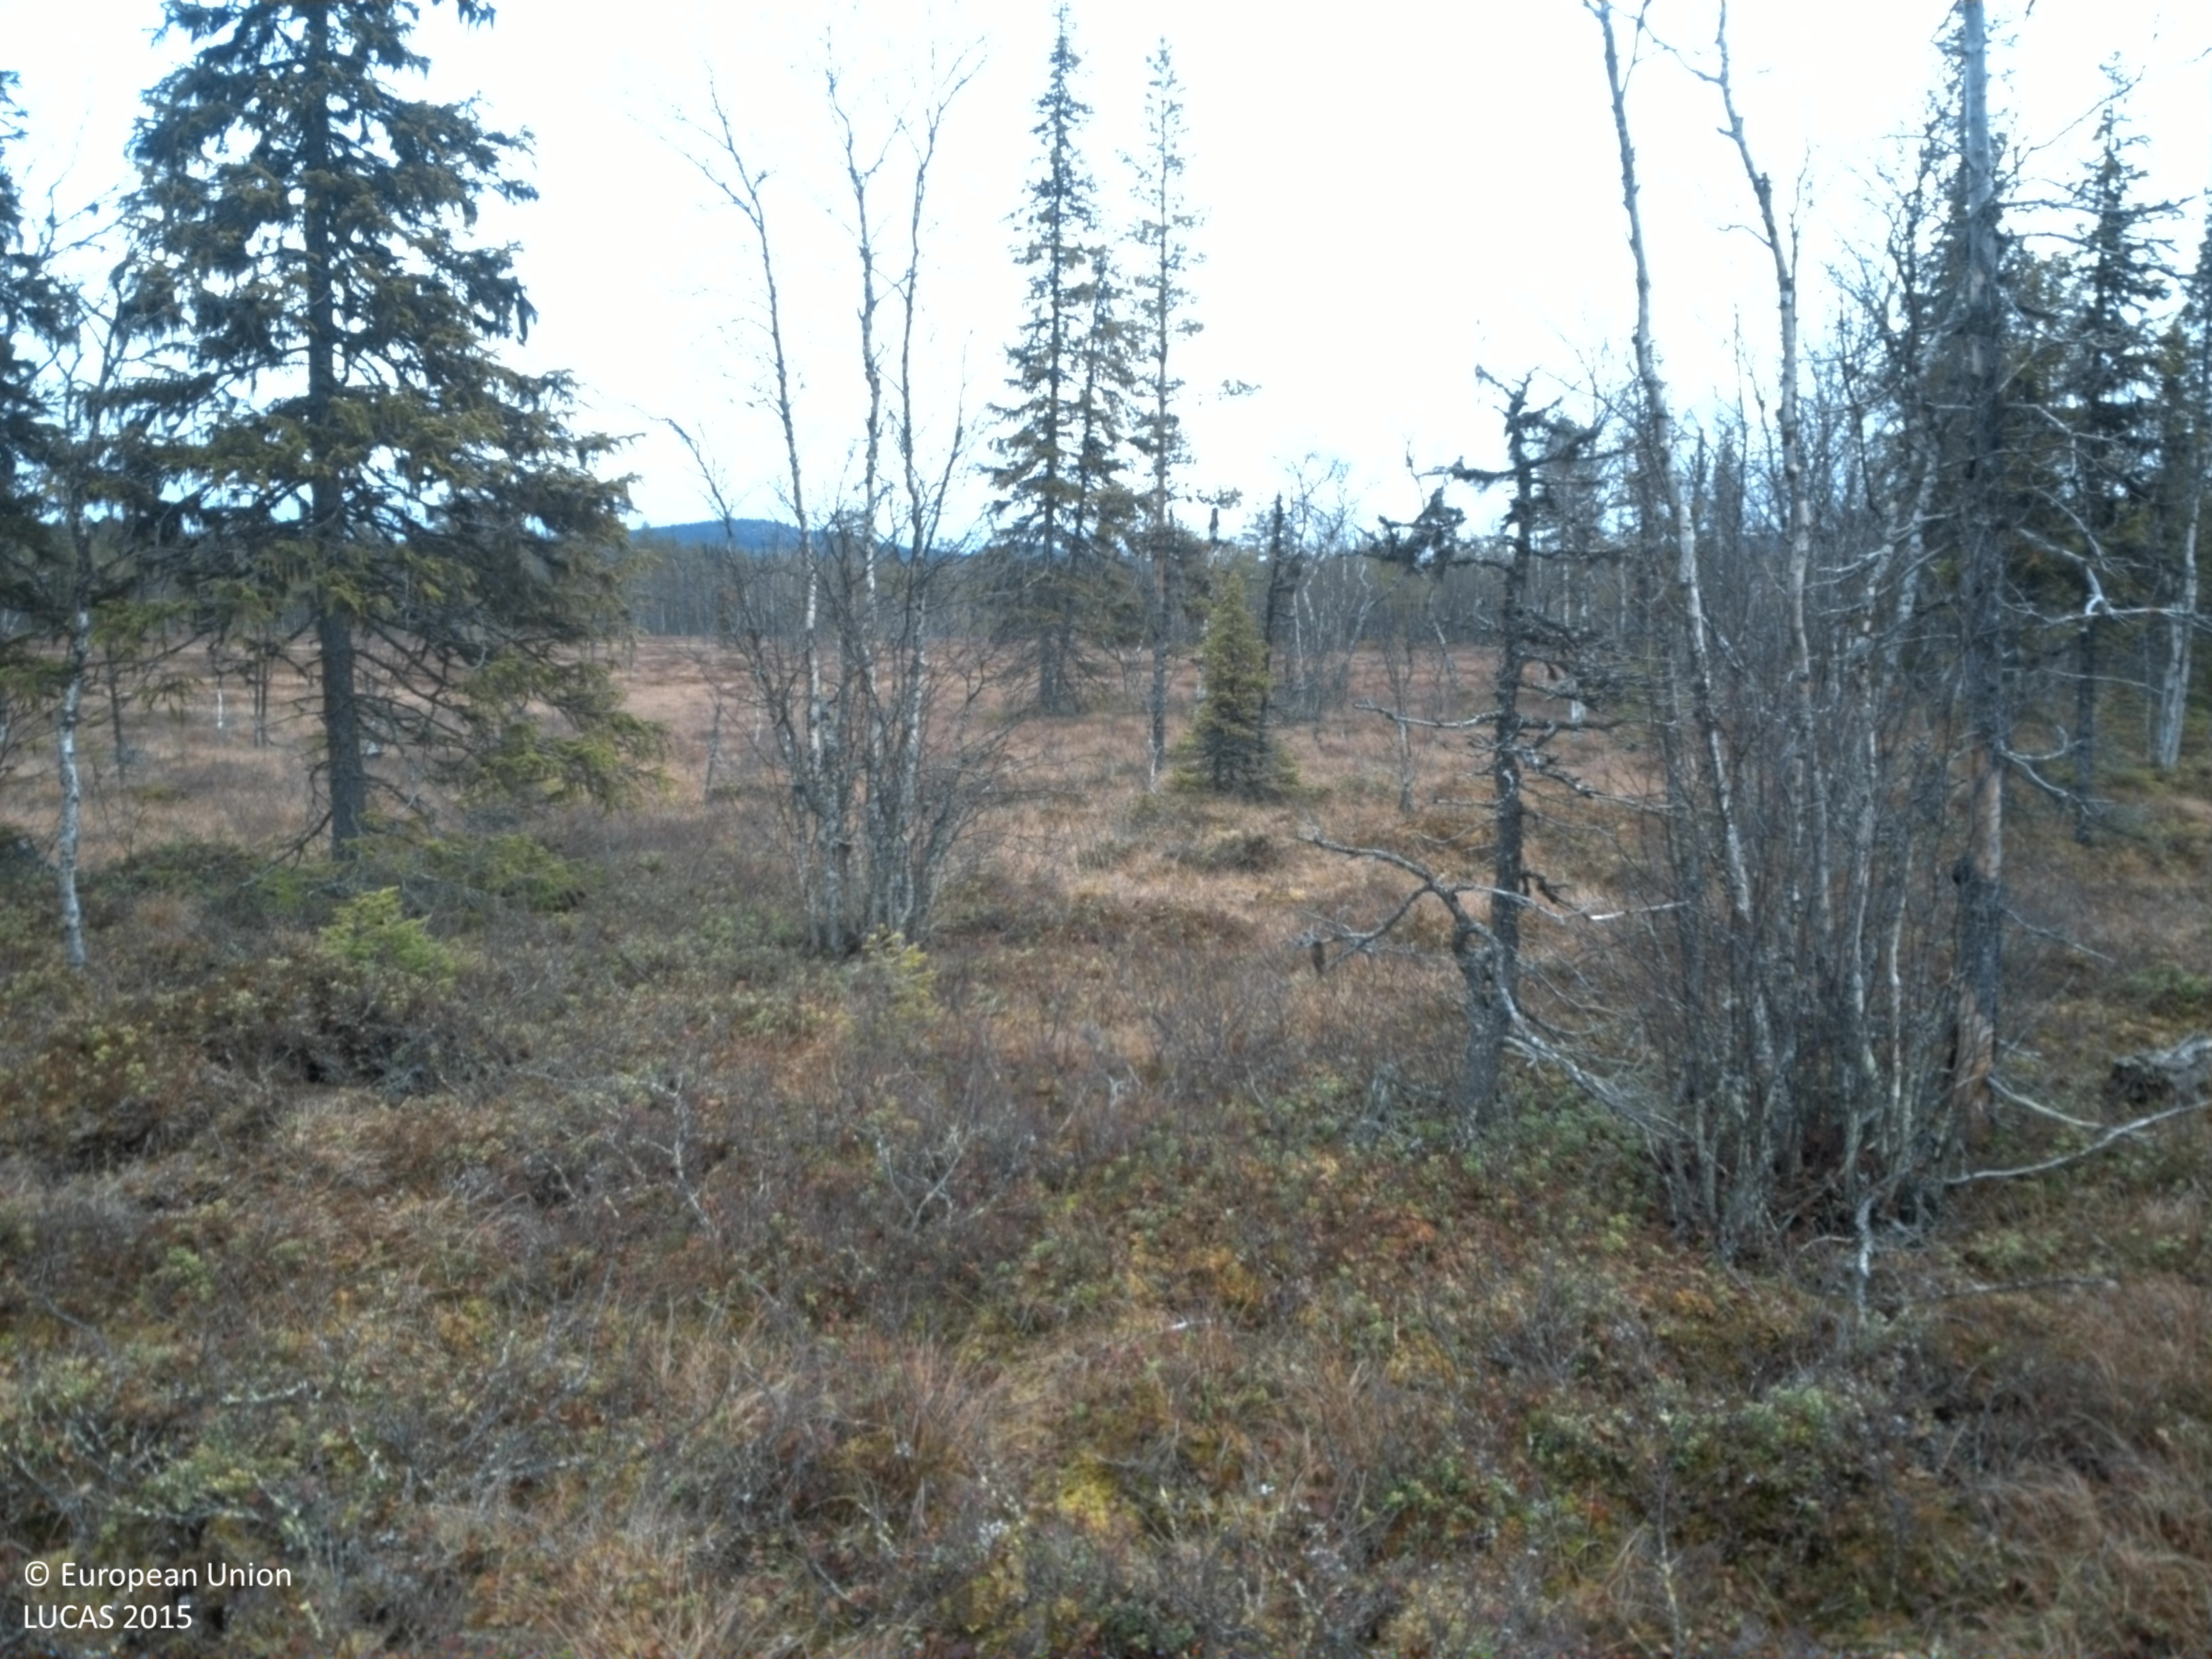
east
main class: Shrubland
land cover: Shrubland with sparse tree cover
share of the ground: 25 - 50 %
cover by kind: herbaceous plants 45 %, shrubs 25 %, lichens and mosses 25 %, coniferous forest trees 5 %
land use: Semi-natural and natural areas not in use
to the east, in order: Shrubland with sparse tree cover; Spruce dominated mixed woodland; Peatbogs; Shrubland without tree cover; Broadleaved woodland; Pine dominated mixed woodland; Other mixed woodland
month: October
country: SE
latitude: 64.4760
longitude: 17.4762
